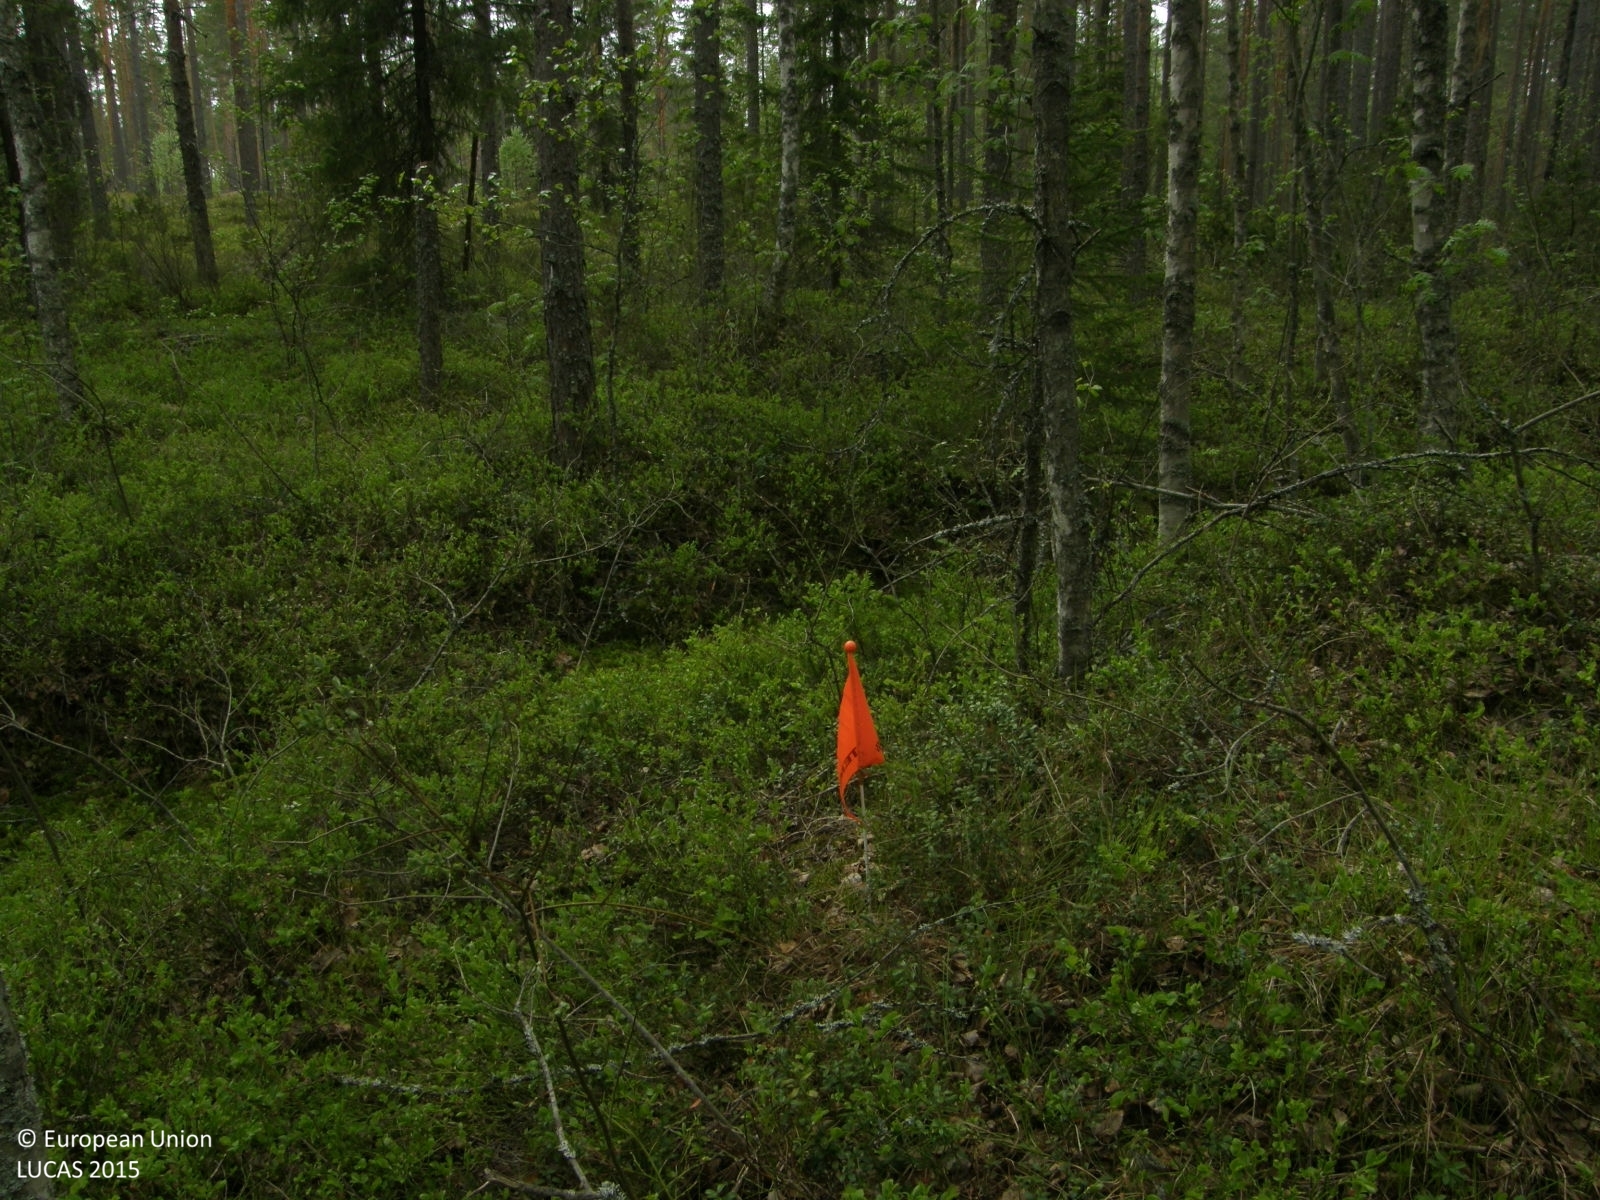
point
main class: Woodland
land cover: Pine dominated mixed woodland
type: boreal forest
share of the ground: > 75 %
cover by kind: coniferous forest trees 55 %, broadleaved forest trees 35 %, shrubs 10 %
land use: Forestry
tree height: > 5 m
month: June
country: FI
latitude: 62.0643
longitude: 22.3605
